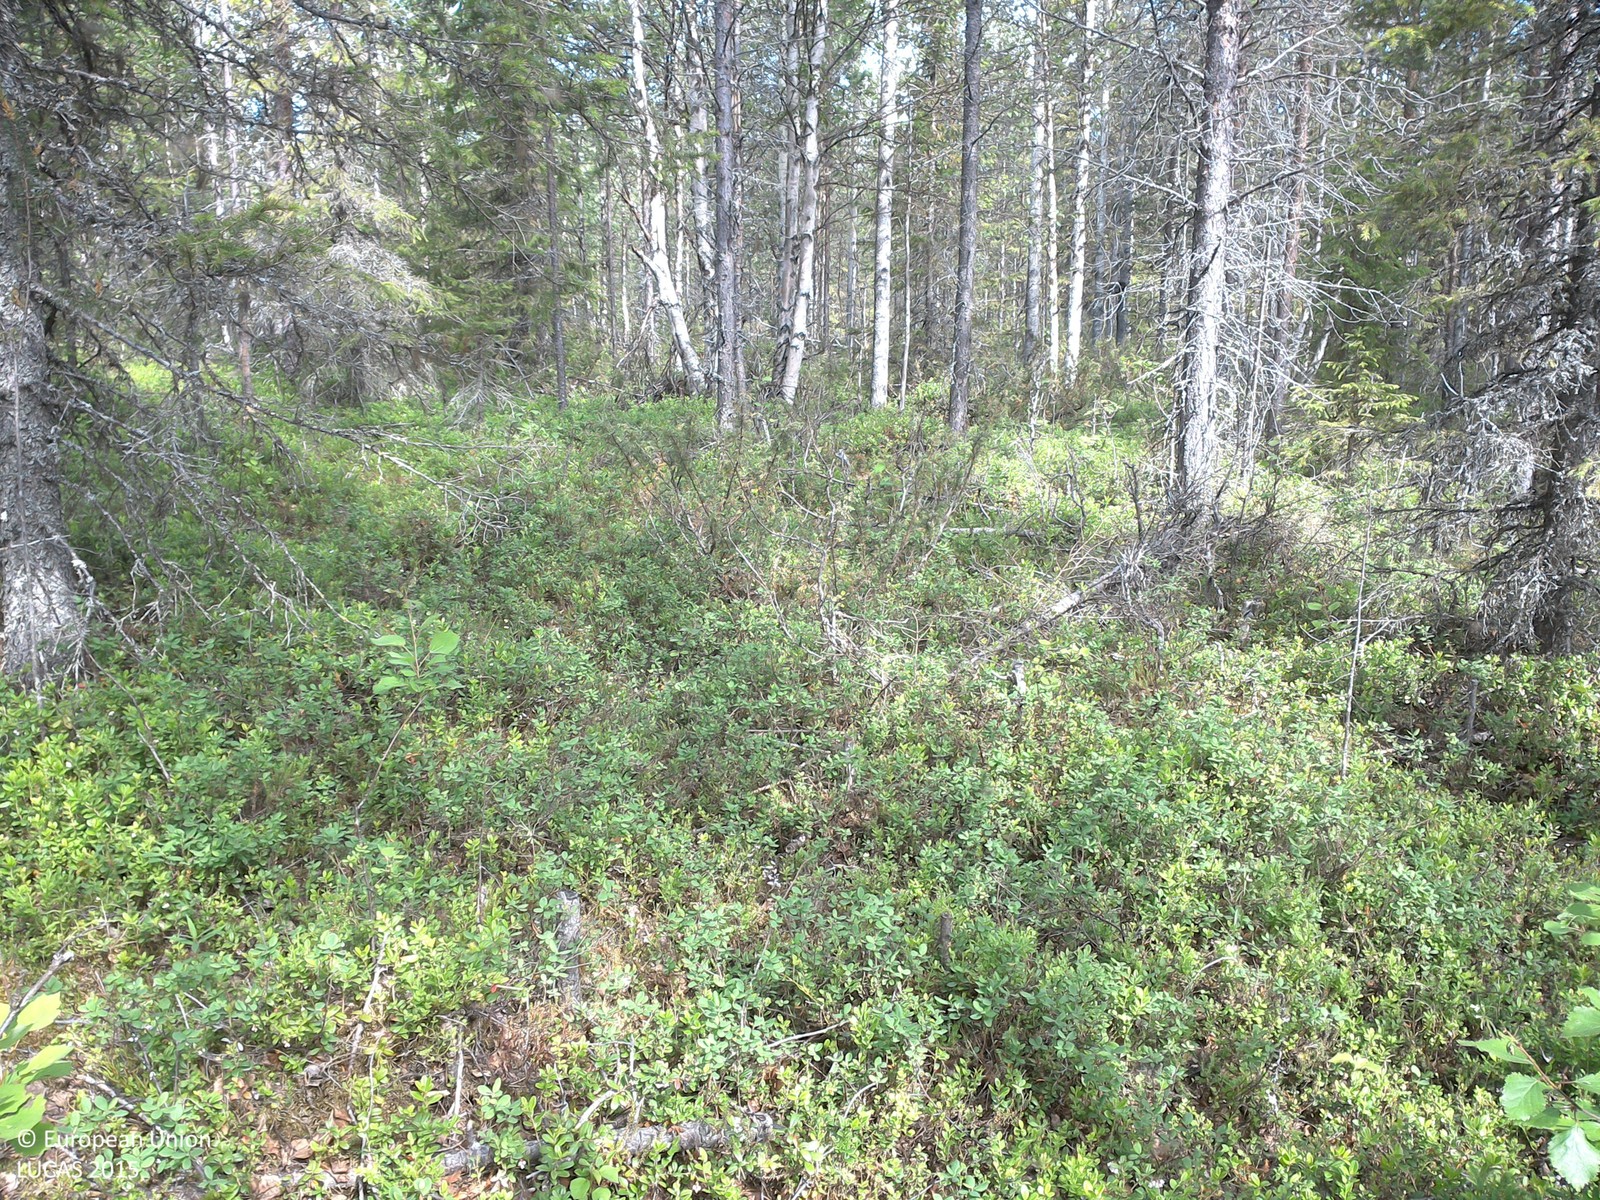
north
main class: Woodland
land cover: Pine dominated mixed woodland
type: boreal forest
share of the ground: 25 - 50 %
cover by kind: shrubs 65 %, coniferous forest trees 25 %, broadleaved forest trees 10 %
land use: Forestry
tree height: > 5 m
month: July
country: SE
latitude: 67.2154
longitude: 23.1352
